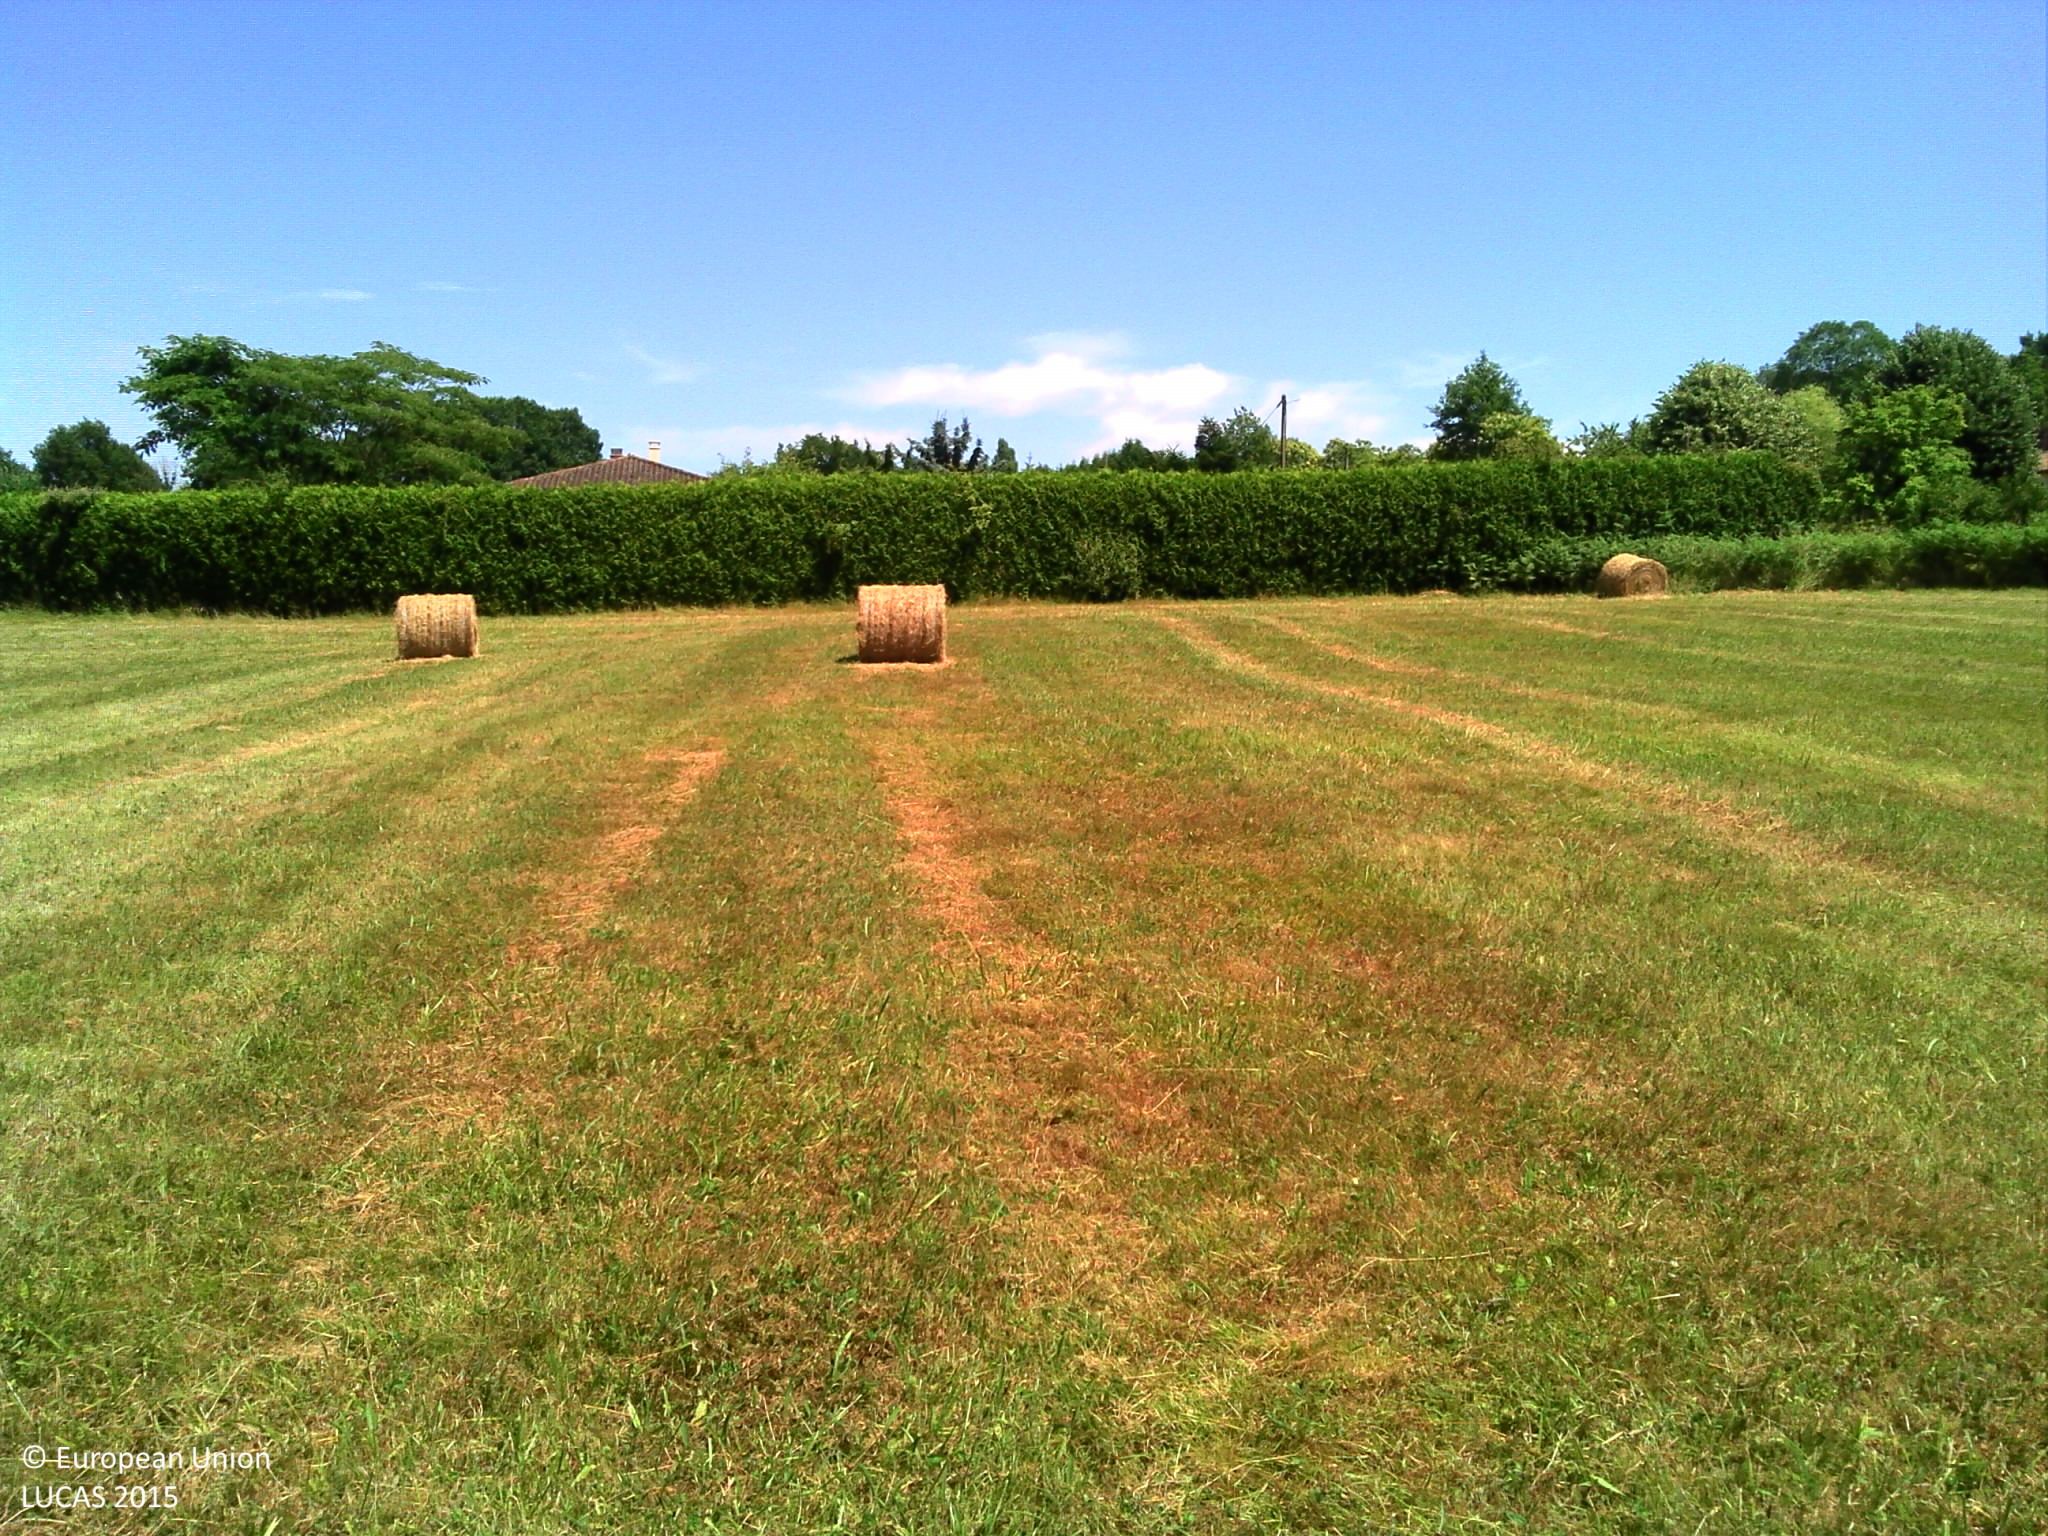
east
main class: Grassland
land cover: Grassland without tree/shrub cover
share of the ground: > 75 %
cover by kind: herbaceous plants 100 %
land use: Agriculture (excluding fallow land and kitchen gardens)
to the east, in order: Grassland without tree/shrub cover; Managed hedges; Artificial constructions in urban areas; Managed hedges; Grassland without tree/shrub cover; Managed hedges; Electric lines; Grass margins; Paved roads, cycling and walking lanes; Grass margins; Ditches and canals; Broadleaved woodland
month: June
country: FR
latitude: 45.7811
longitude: 0.6880
